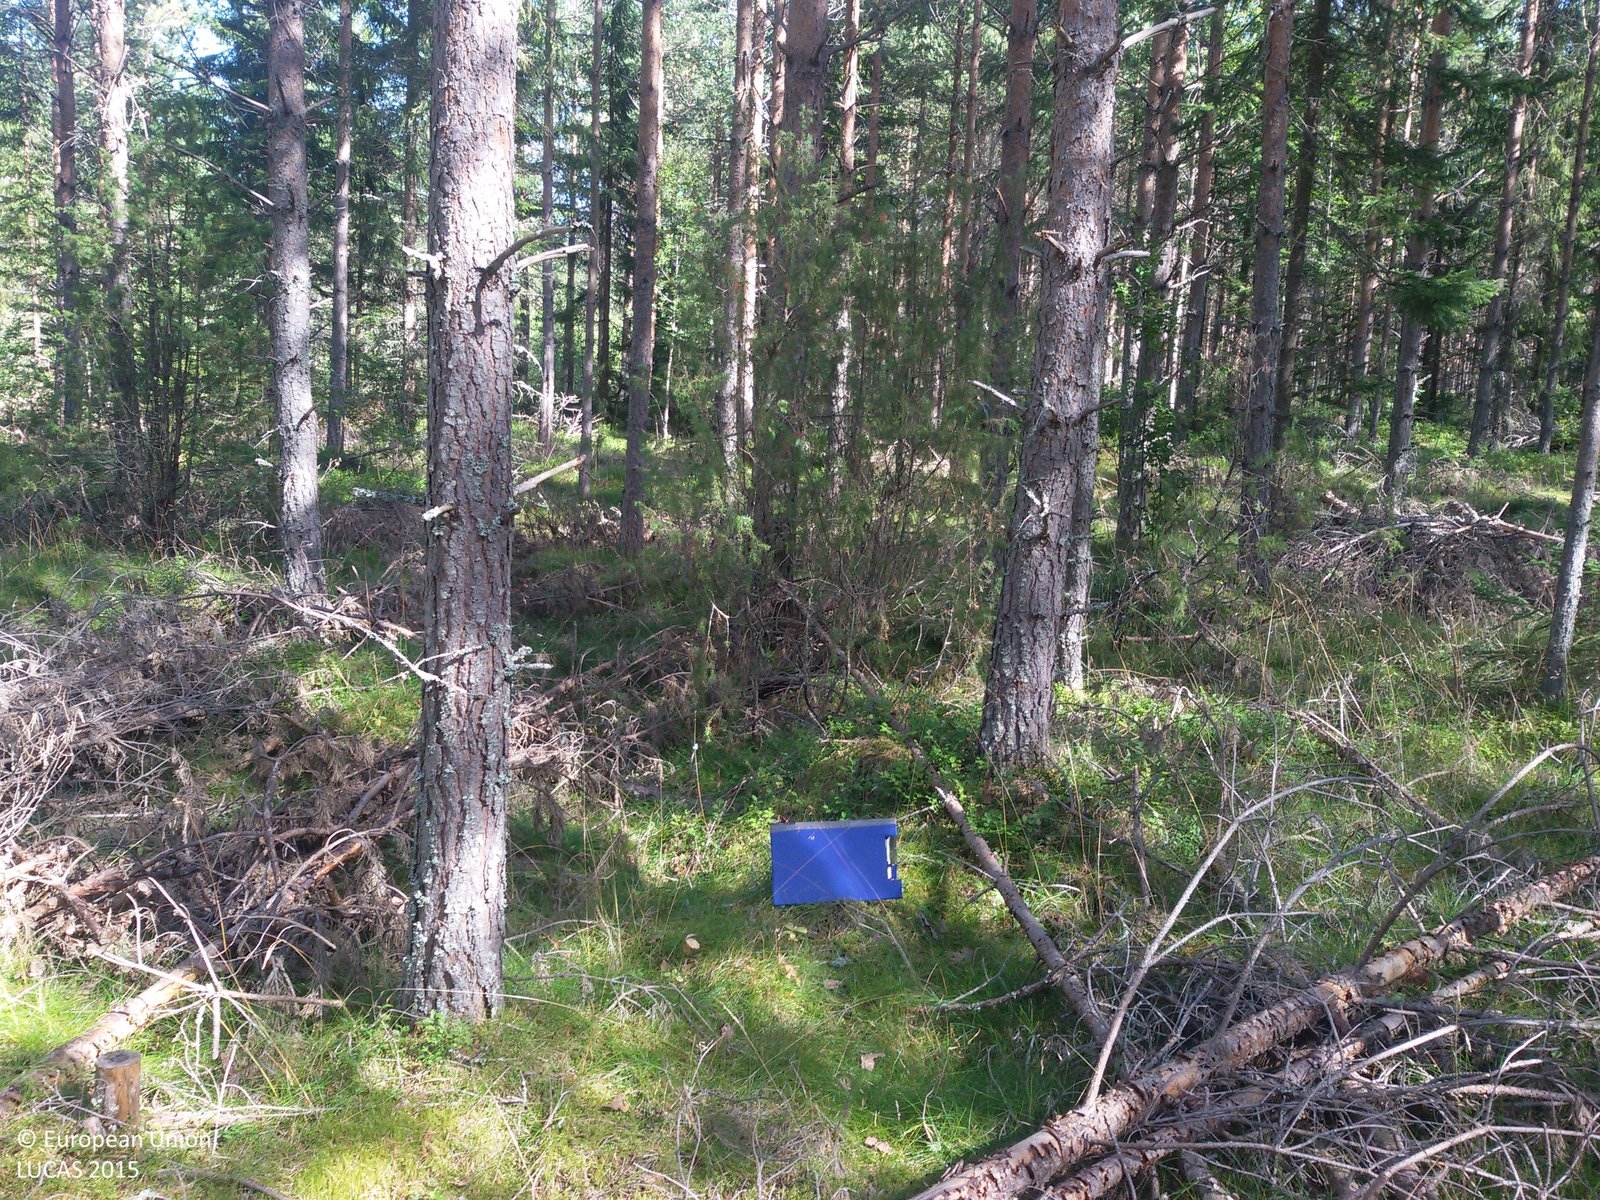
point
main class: Woodland
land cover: Pine dominated coniferous woodland
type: boreal forest
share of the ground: > 75 %
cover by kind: coniferous forest trees 80 %, herbaceous plants 15 %, lichens and mosses 5 %
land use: Forestry
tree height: > 5 m
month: August
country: SE
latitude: 60.6443
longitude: 15.6744
